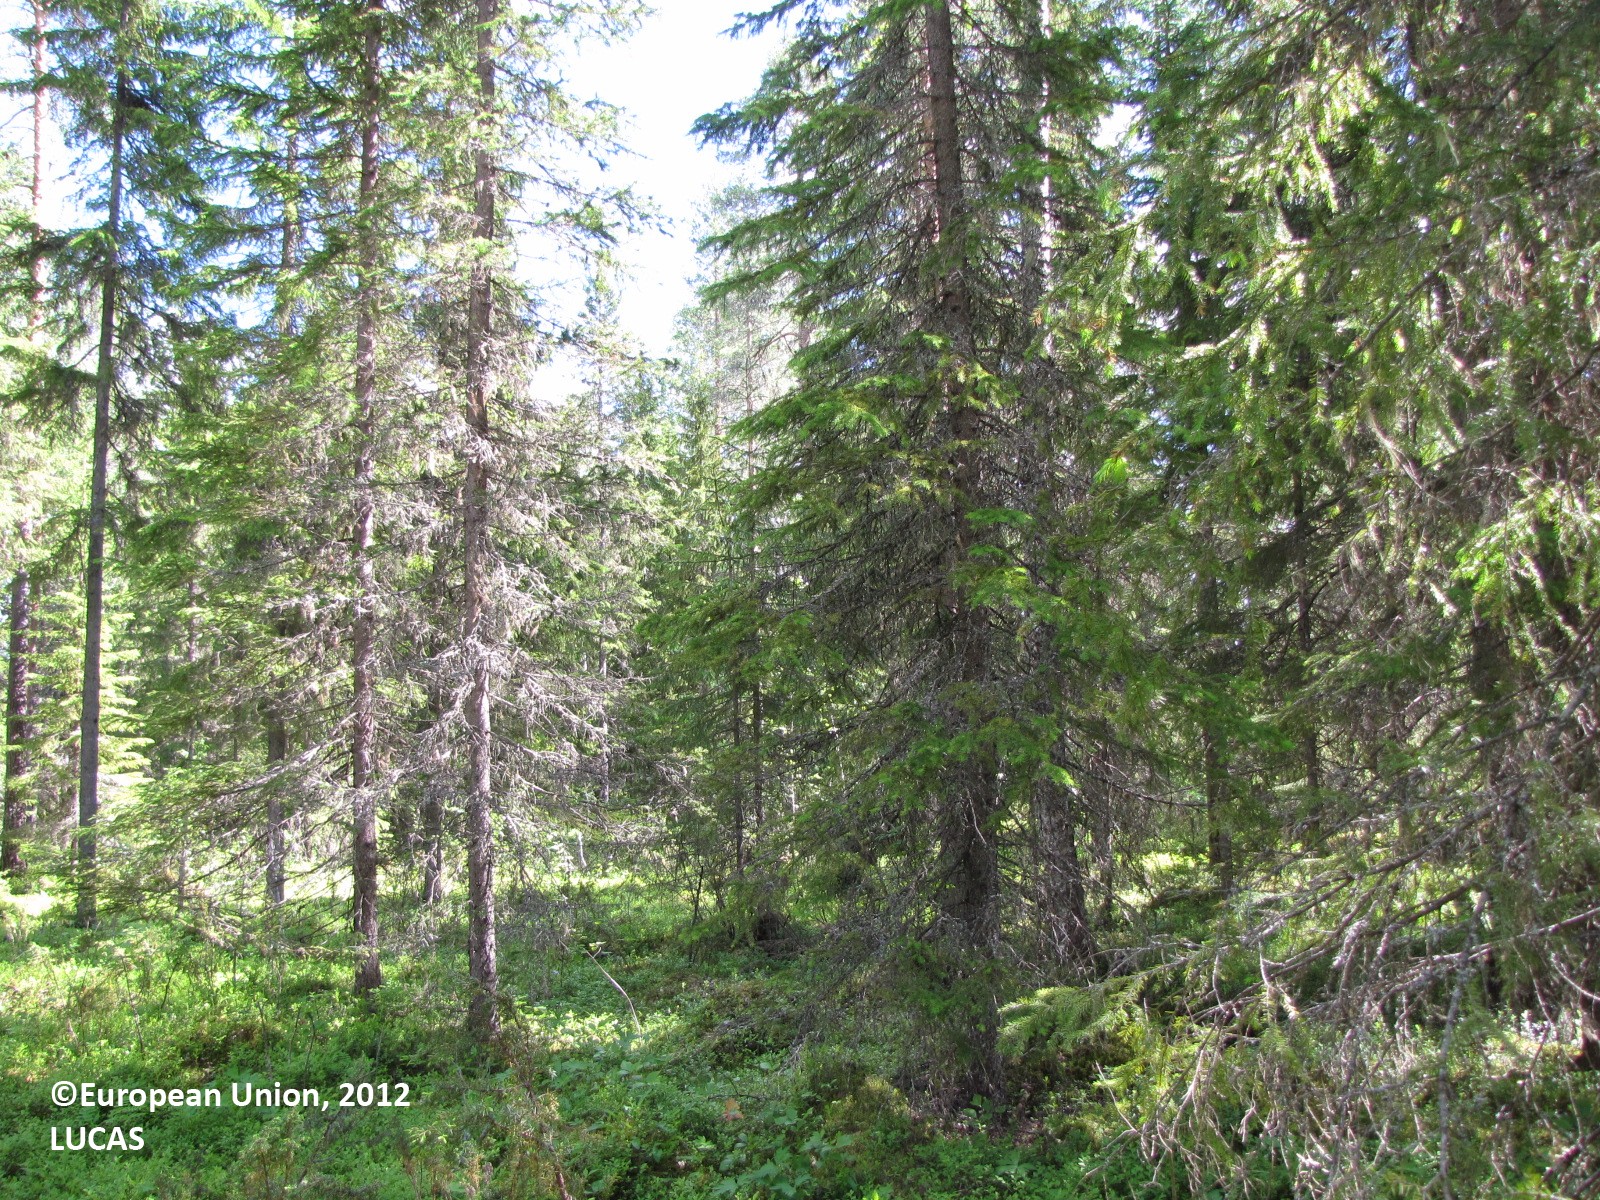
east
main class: Woodland
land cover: Spruce dominated coniferous woodland
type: boreal forest
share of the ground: 50 - 75 %
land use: Forestry
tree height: > 5 m
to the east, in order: Spruce dominated coniferous woodland; Tracks; Other mixed woodland; Spruce dominated mixed woodland; Pine dominated coniferous woodland; Pine dominated mixed woodland
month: July
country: FI
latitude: 66.1811
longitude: 25.1281
